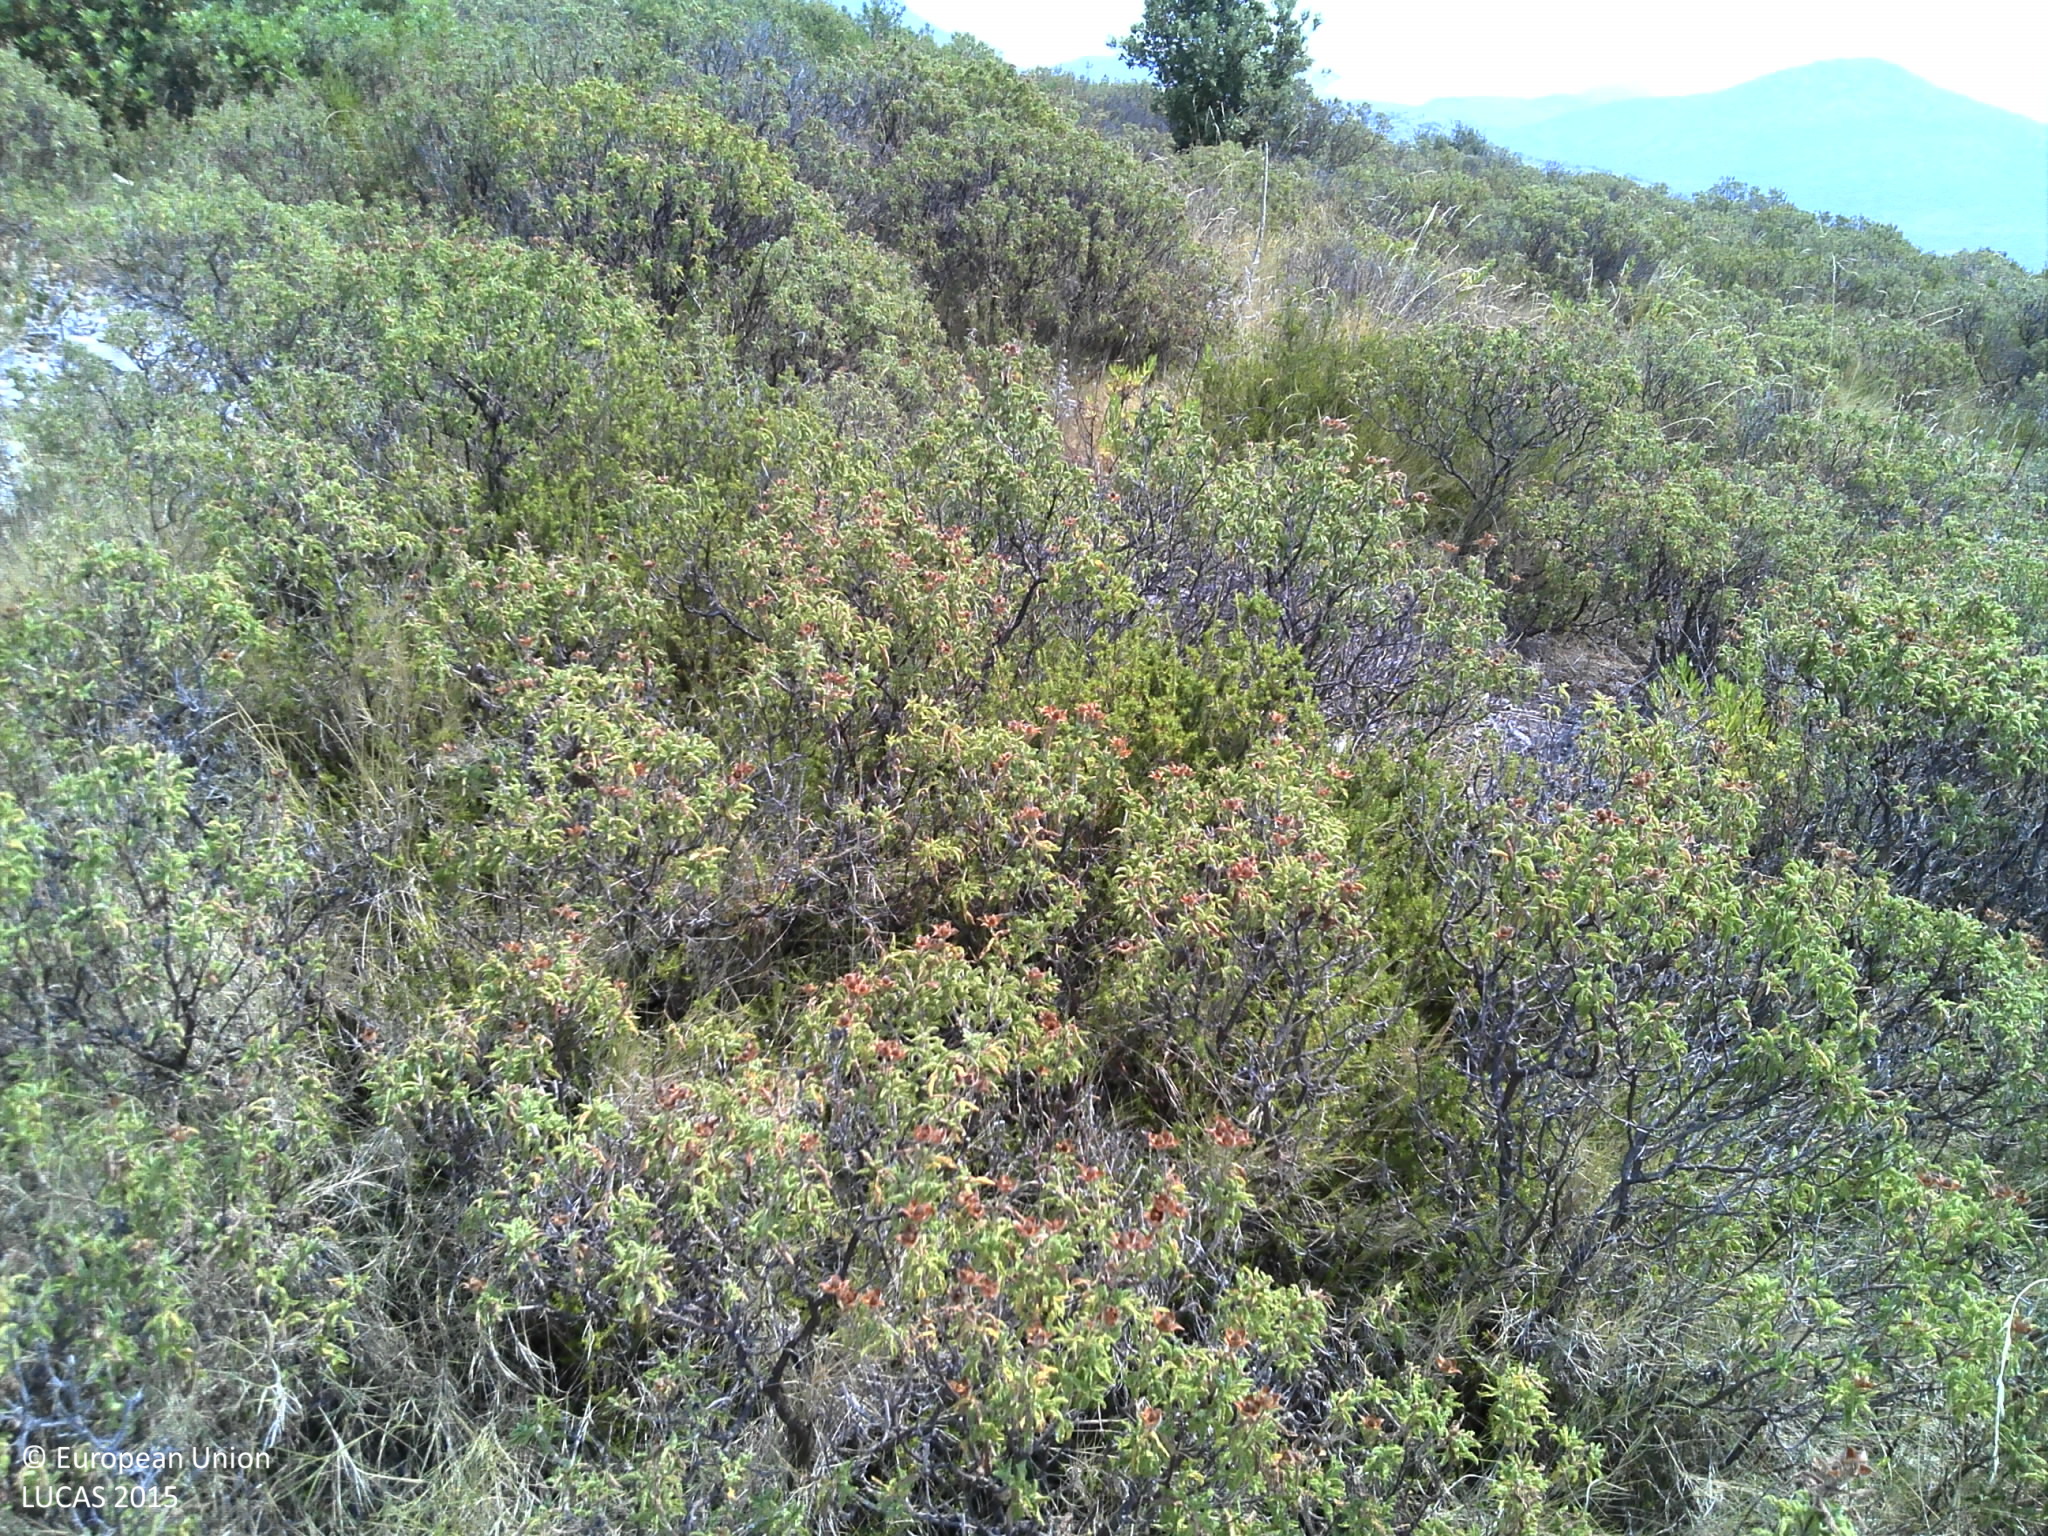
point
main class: Shrubland
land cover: Shrubland without tree cover
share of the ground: 50 - 75 %
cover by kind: shrubs 50 %, herbaceous plants 25 %, consolidated bare surface 25 %
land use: Semi-natural and natural areas not in use
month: July
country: HR
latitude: 42.8041
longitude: 17.8284
